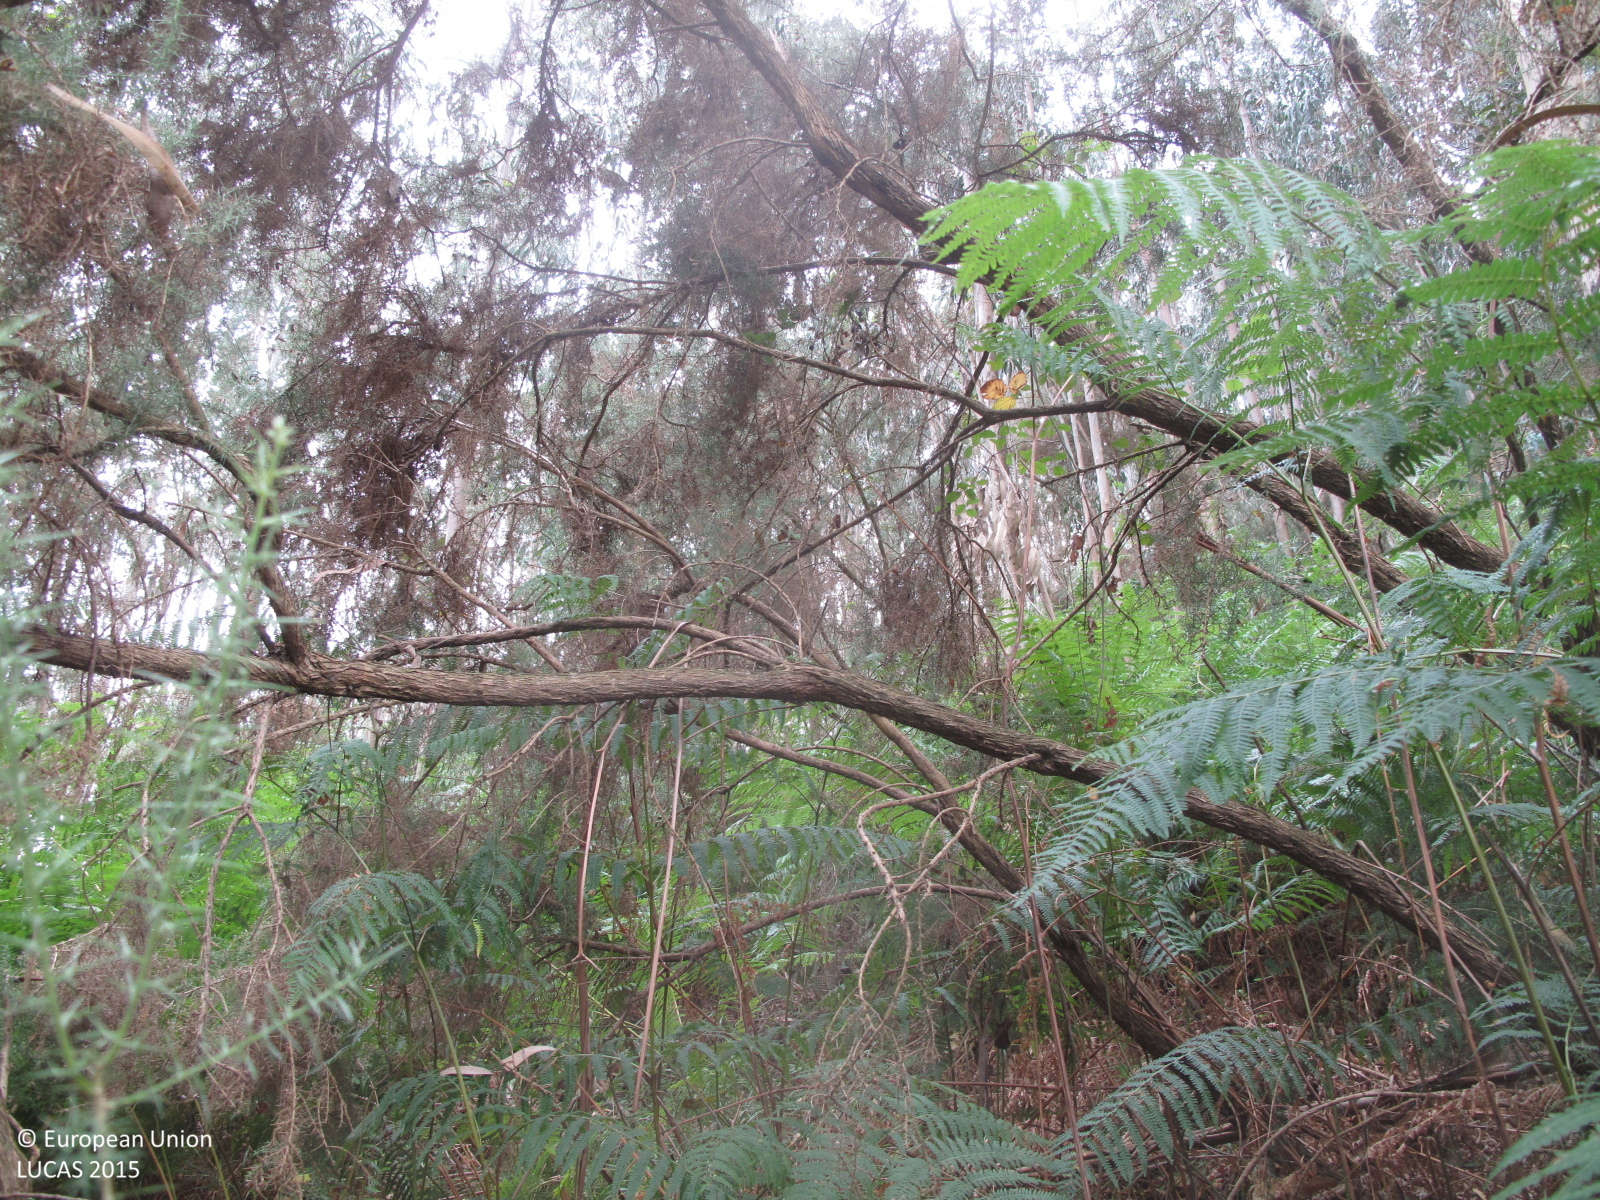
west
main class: Woodland
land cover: Broadleaved woodland
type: exotic forest
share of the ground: 50 - 75 %
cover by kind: broadleaved forest trees 60 %, shrubs 20 %, herbaceous plants 20 %
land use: Forestry
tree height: > 5 m
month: July
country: ES
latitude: 43.6346
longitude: -7.8555
